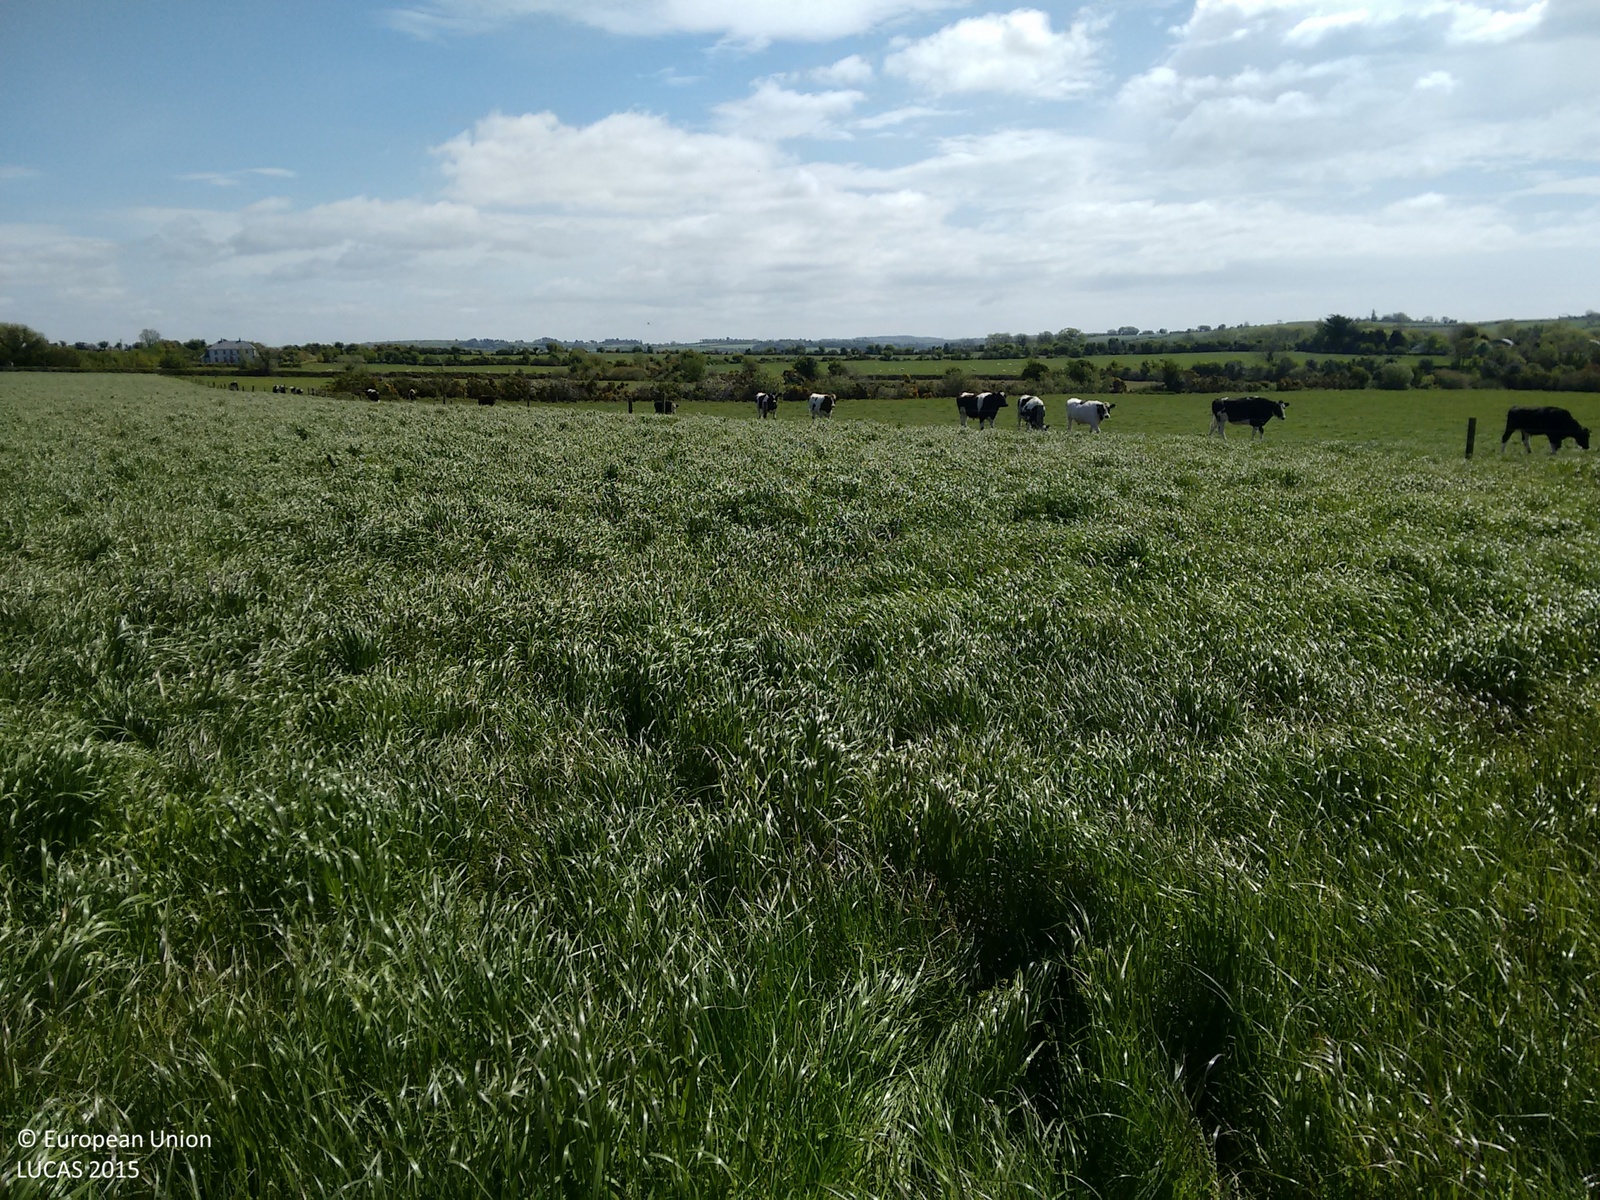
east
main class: Grassland
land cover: Grassland without tree/shrub cover
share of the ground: > 75 %
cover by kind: herbaceous plants 100 %
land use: Agriculture (excluding fallow land and kitchen gardens)
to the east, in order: Grassland without tree/shrub cover; Fences; Grassland without tree/shrub cover; Fences; Ditches and canals; Abandoned hedges; Fences; Grassland without tree/shrub cover; Fences; Grassland without tree/shrub cover
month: May
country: IE
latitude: 52.2091
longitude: -7.4704
